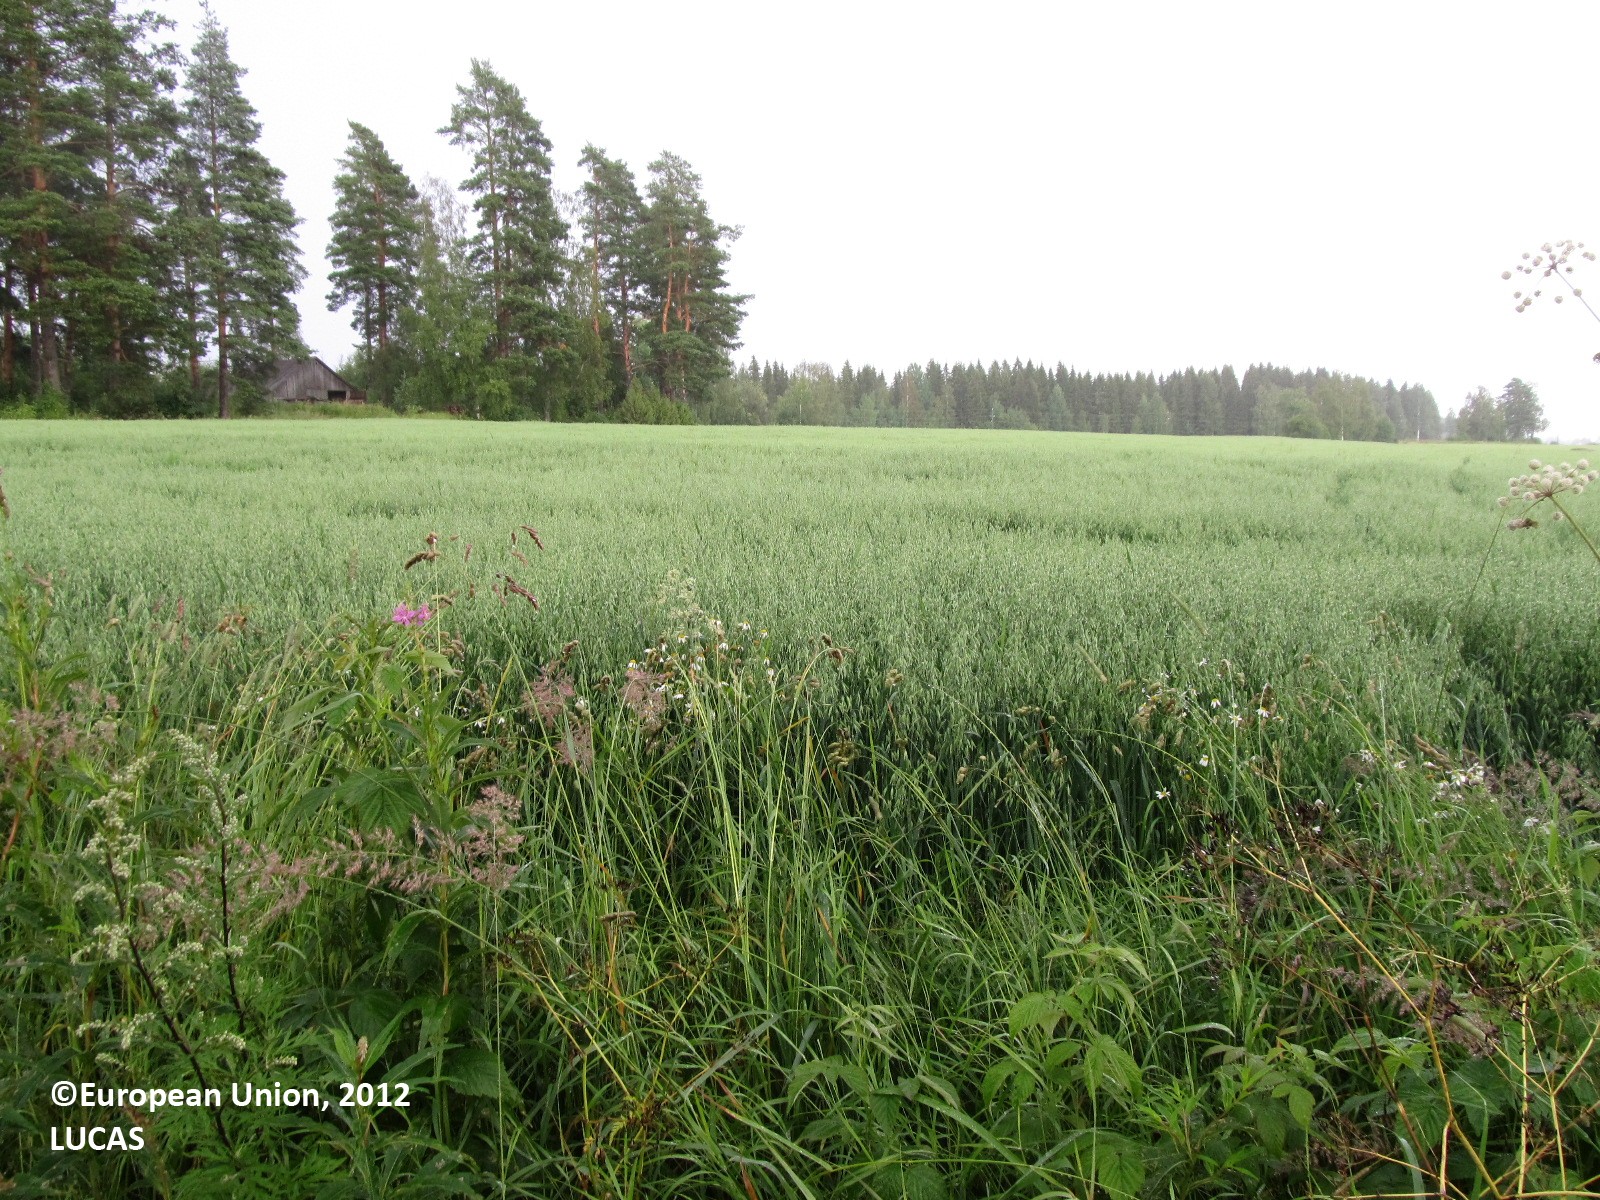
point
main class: Cropland
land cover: Oats
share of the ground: > 75 %
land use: Agriculture (excluding fallow land and kitchen gardens)
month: July
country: FI
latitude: 62.0141
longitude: 28.4477
